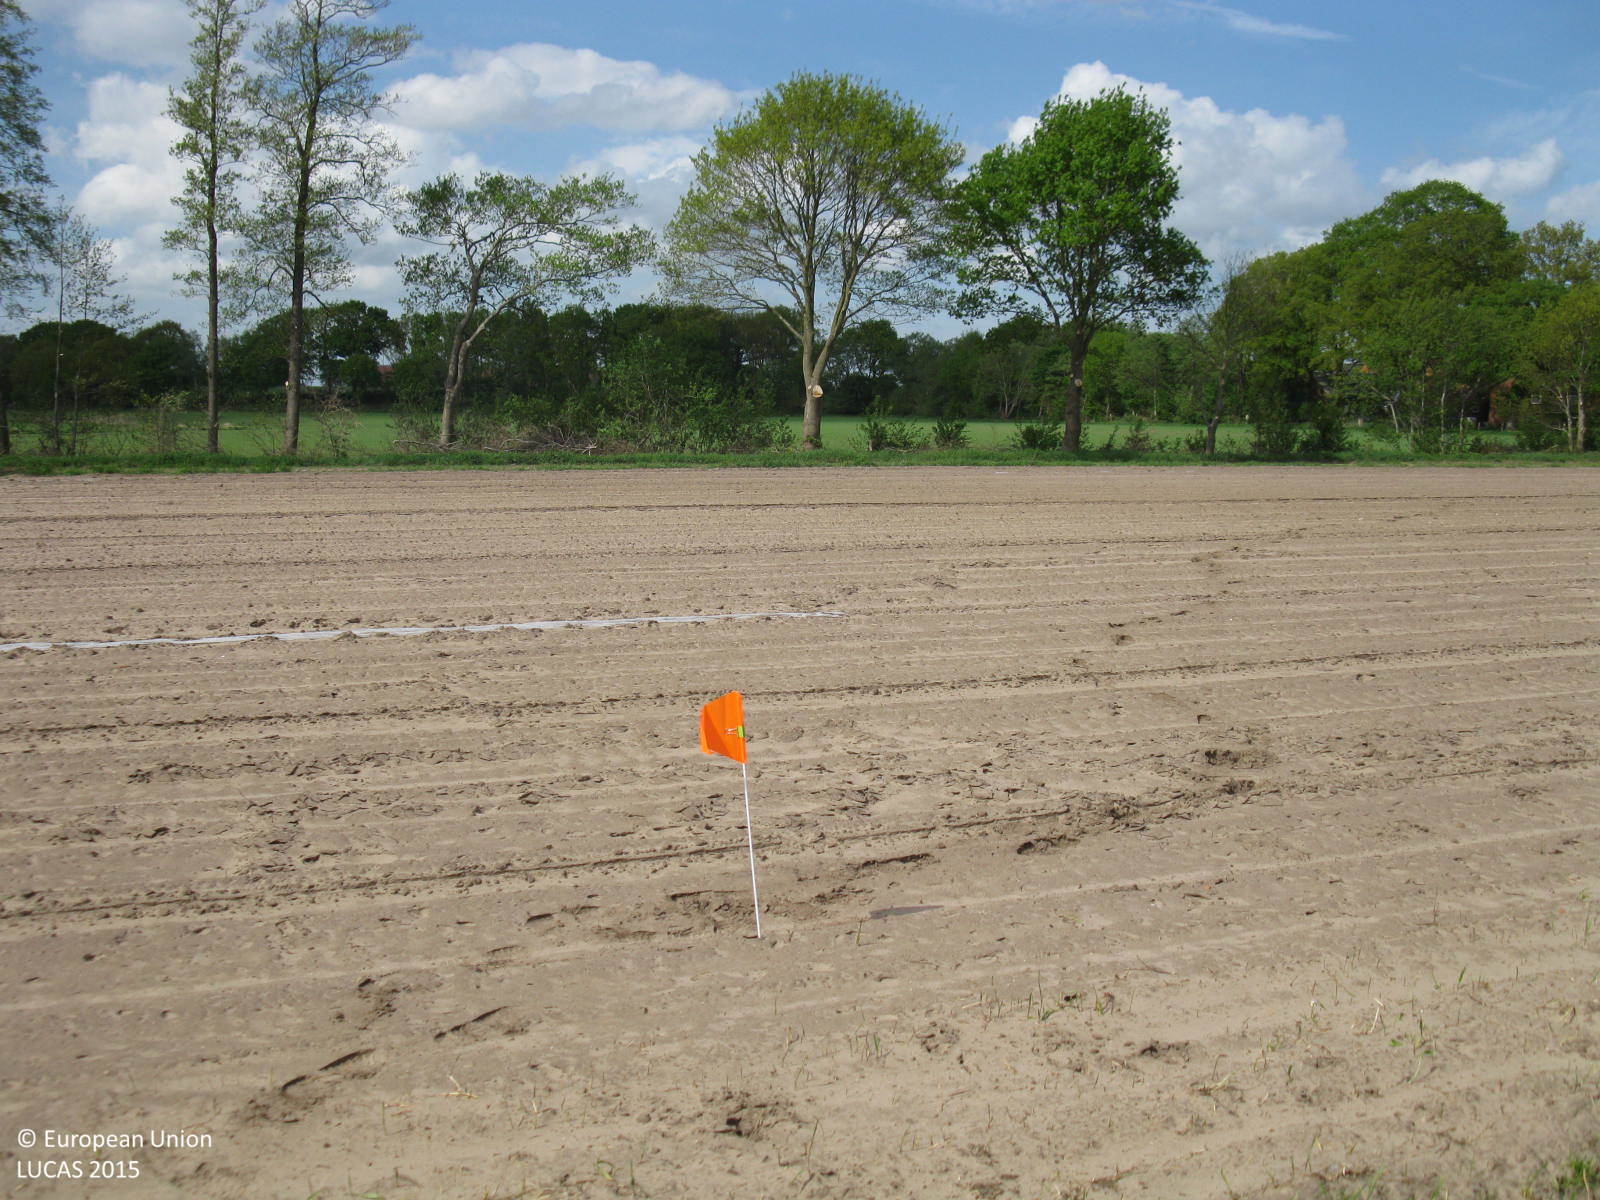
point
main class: Cropland
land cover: Other fresh vegetables
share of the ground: 25 - 50 %
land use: Agriculture (excluding fallow land and kitchen gardens)
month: May
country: DE
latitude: 52.9950
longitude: 7.3336
